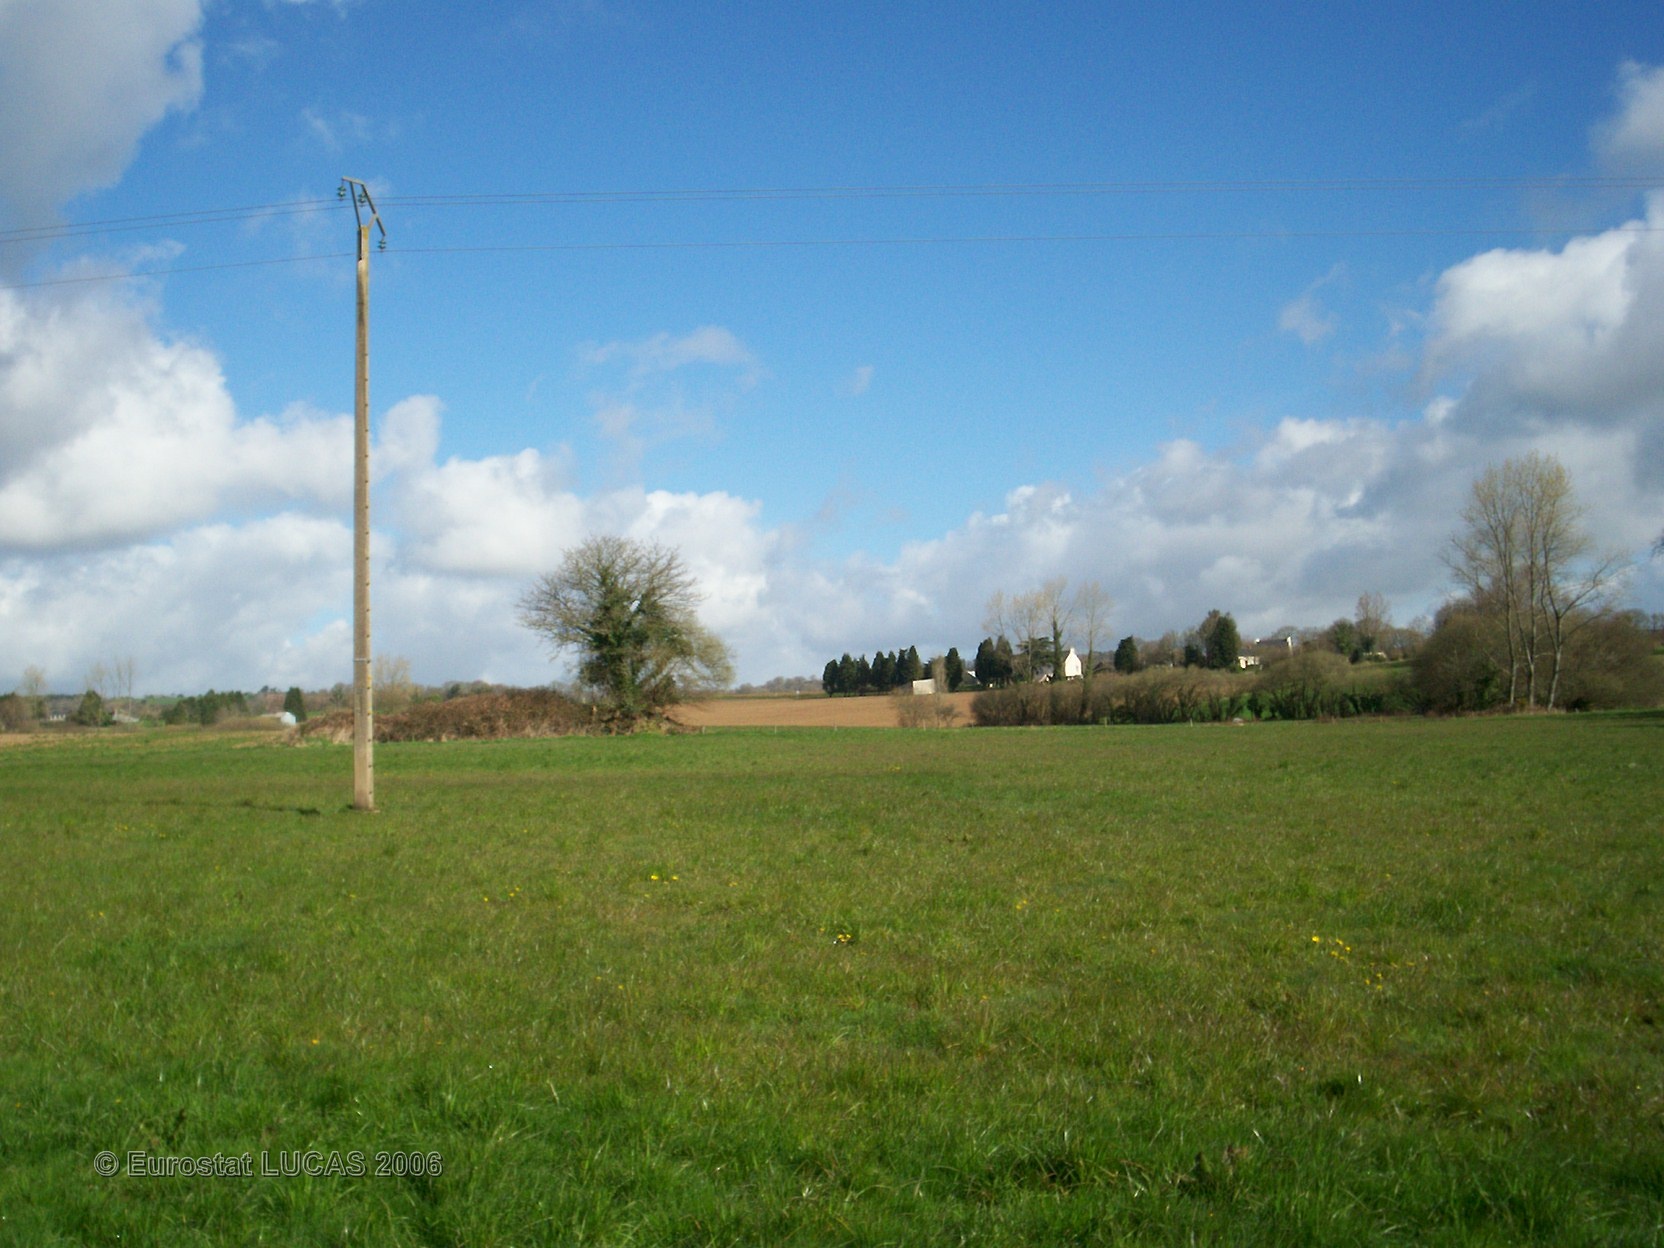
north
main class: Grassland
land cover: Grassland without tree/shrub cover
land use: Agriculture (excluding fallow land and kitchen gardens)
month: April
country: FR
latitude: 48.1340
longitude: -3.6656
